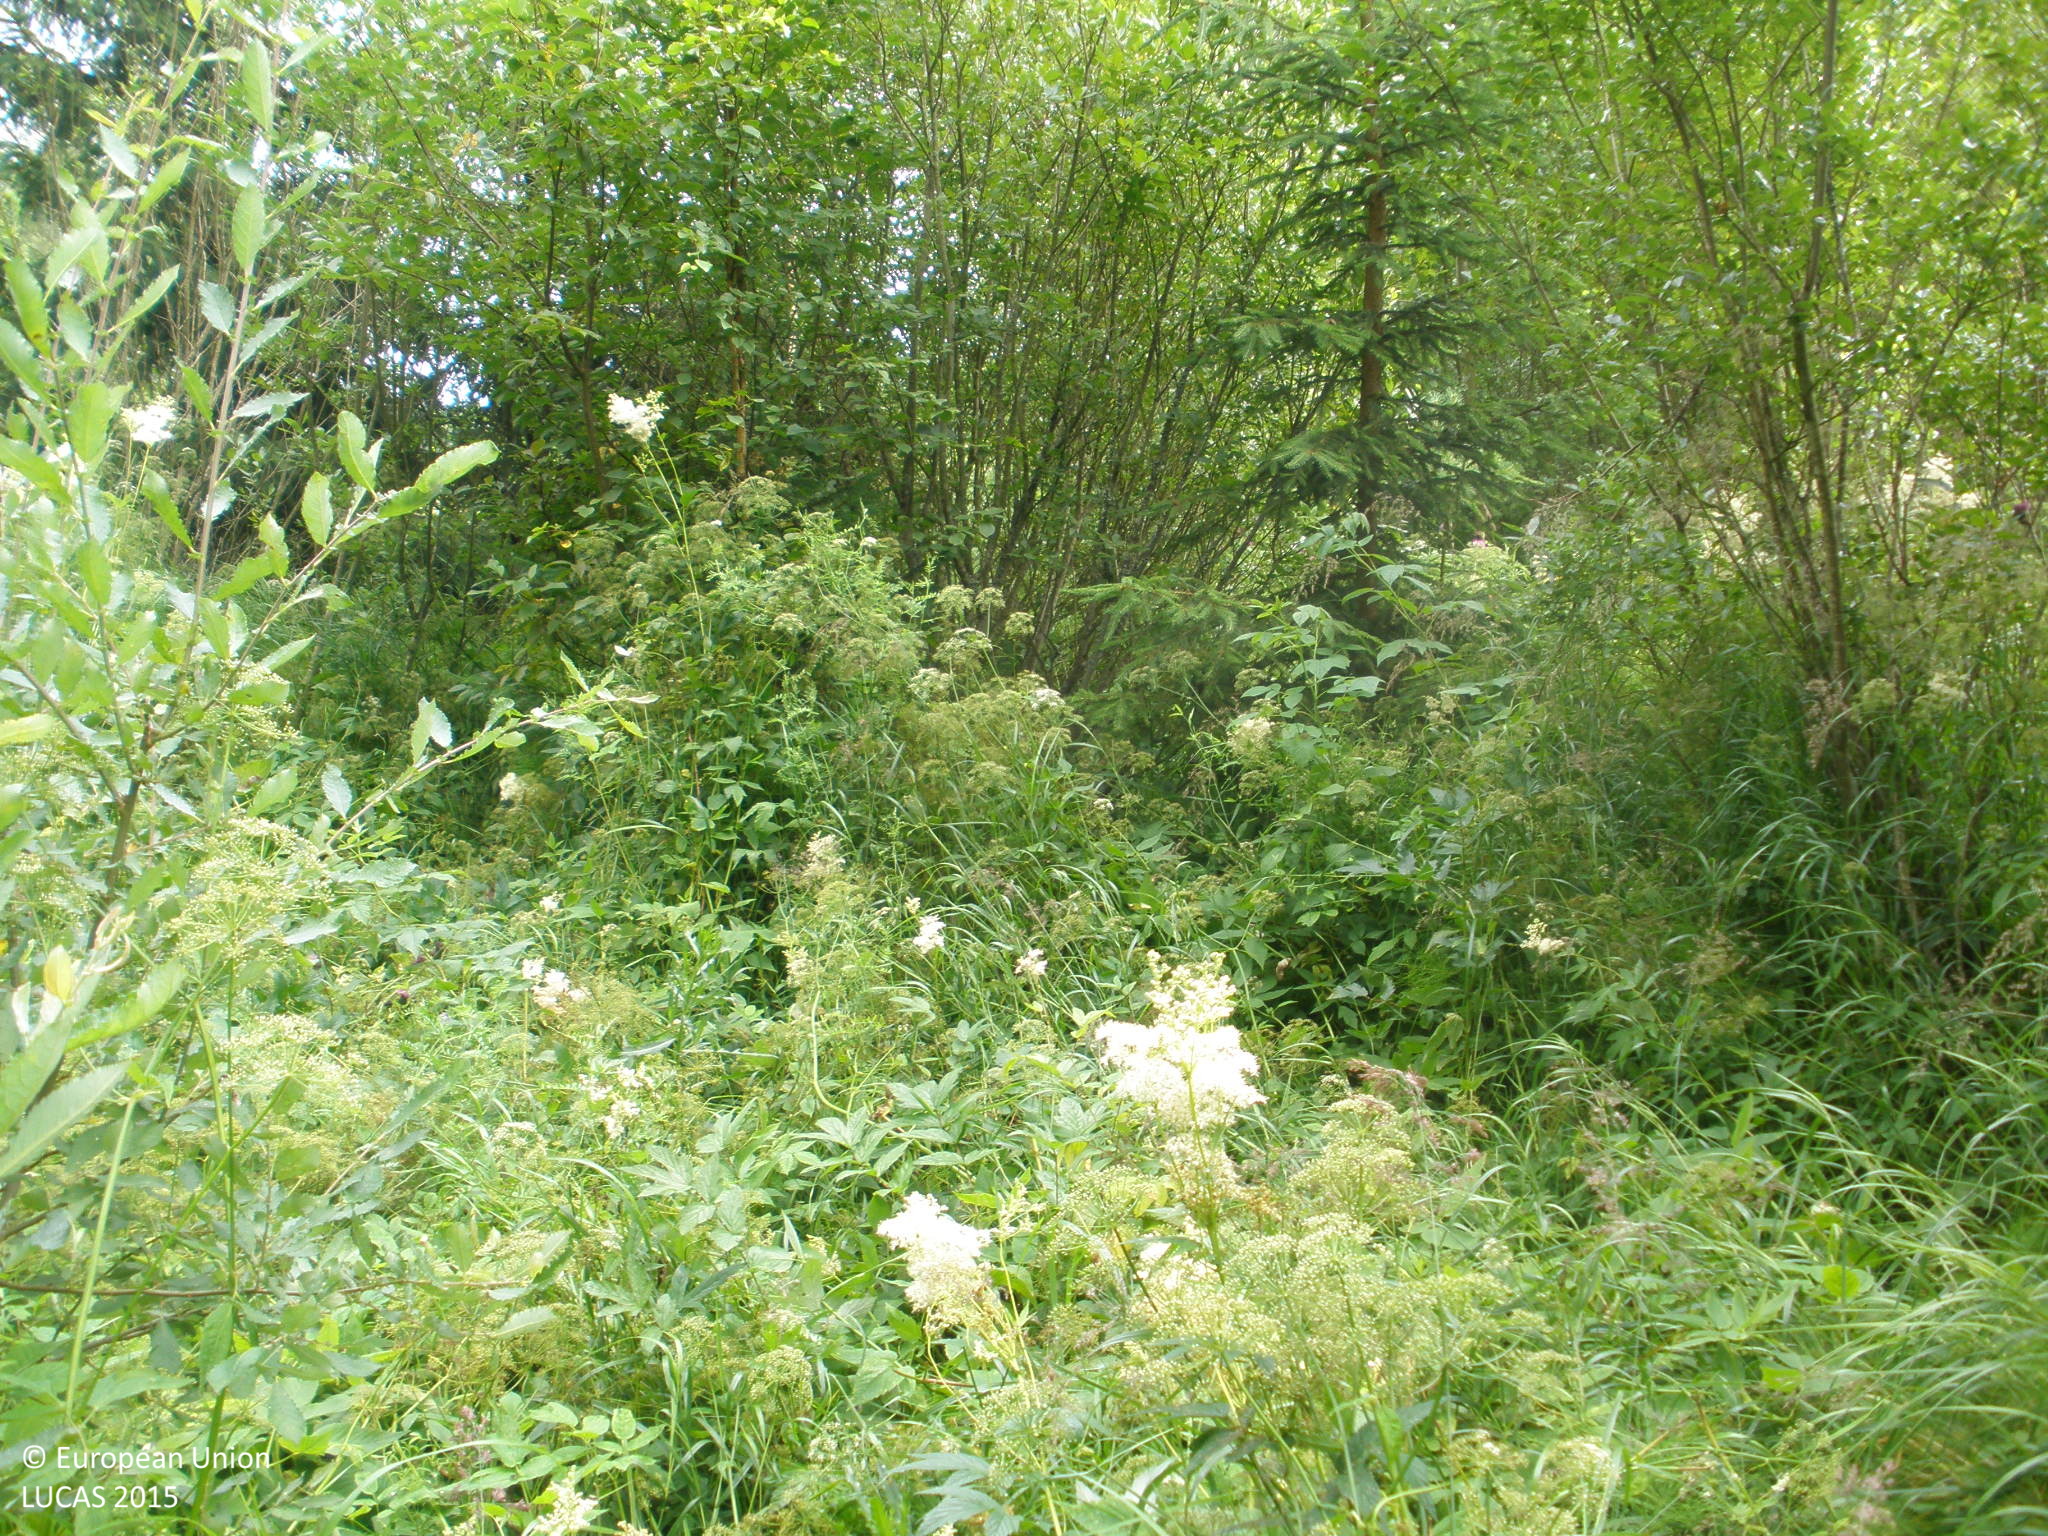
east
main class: Shrubland
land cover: Shrubland with sparse tree cover
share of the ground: 50 - 75 %
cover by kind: shrubs 50 %, herbaceous plants 45 %, broadleaved forest trees 5 %
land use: Semi-natural and natural areas not in use
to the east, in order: Shrubland with sparse tree cover; Other mixed woodland; Temporary grasslands; Electric lines; Spontaneously vegetated surfaces; Paved roads, cycling and walking lanes; Ditches and canals; Grass margins; Common wheat
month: July
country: FI
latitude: 60.6840
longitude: 23.4690
